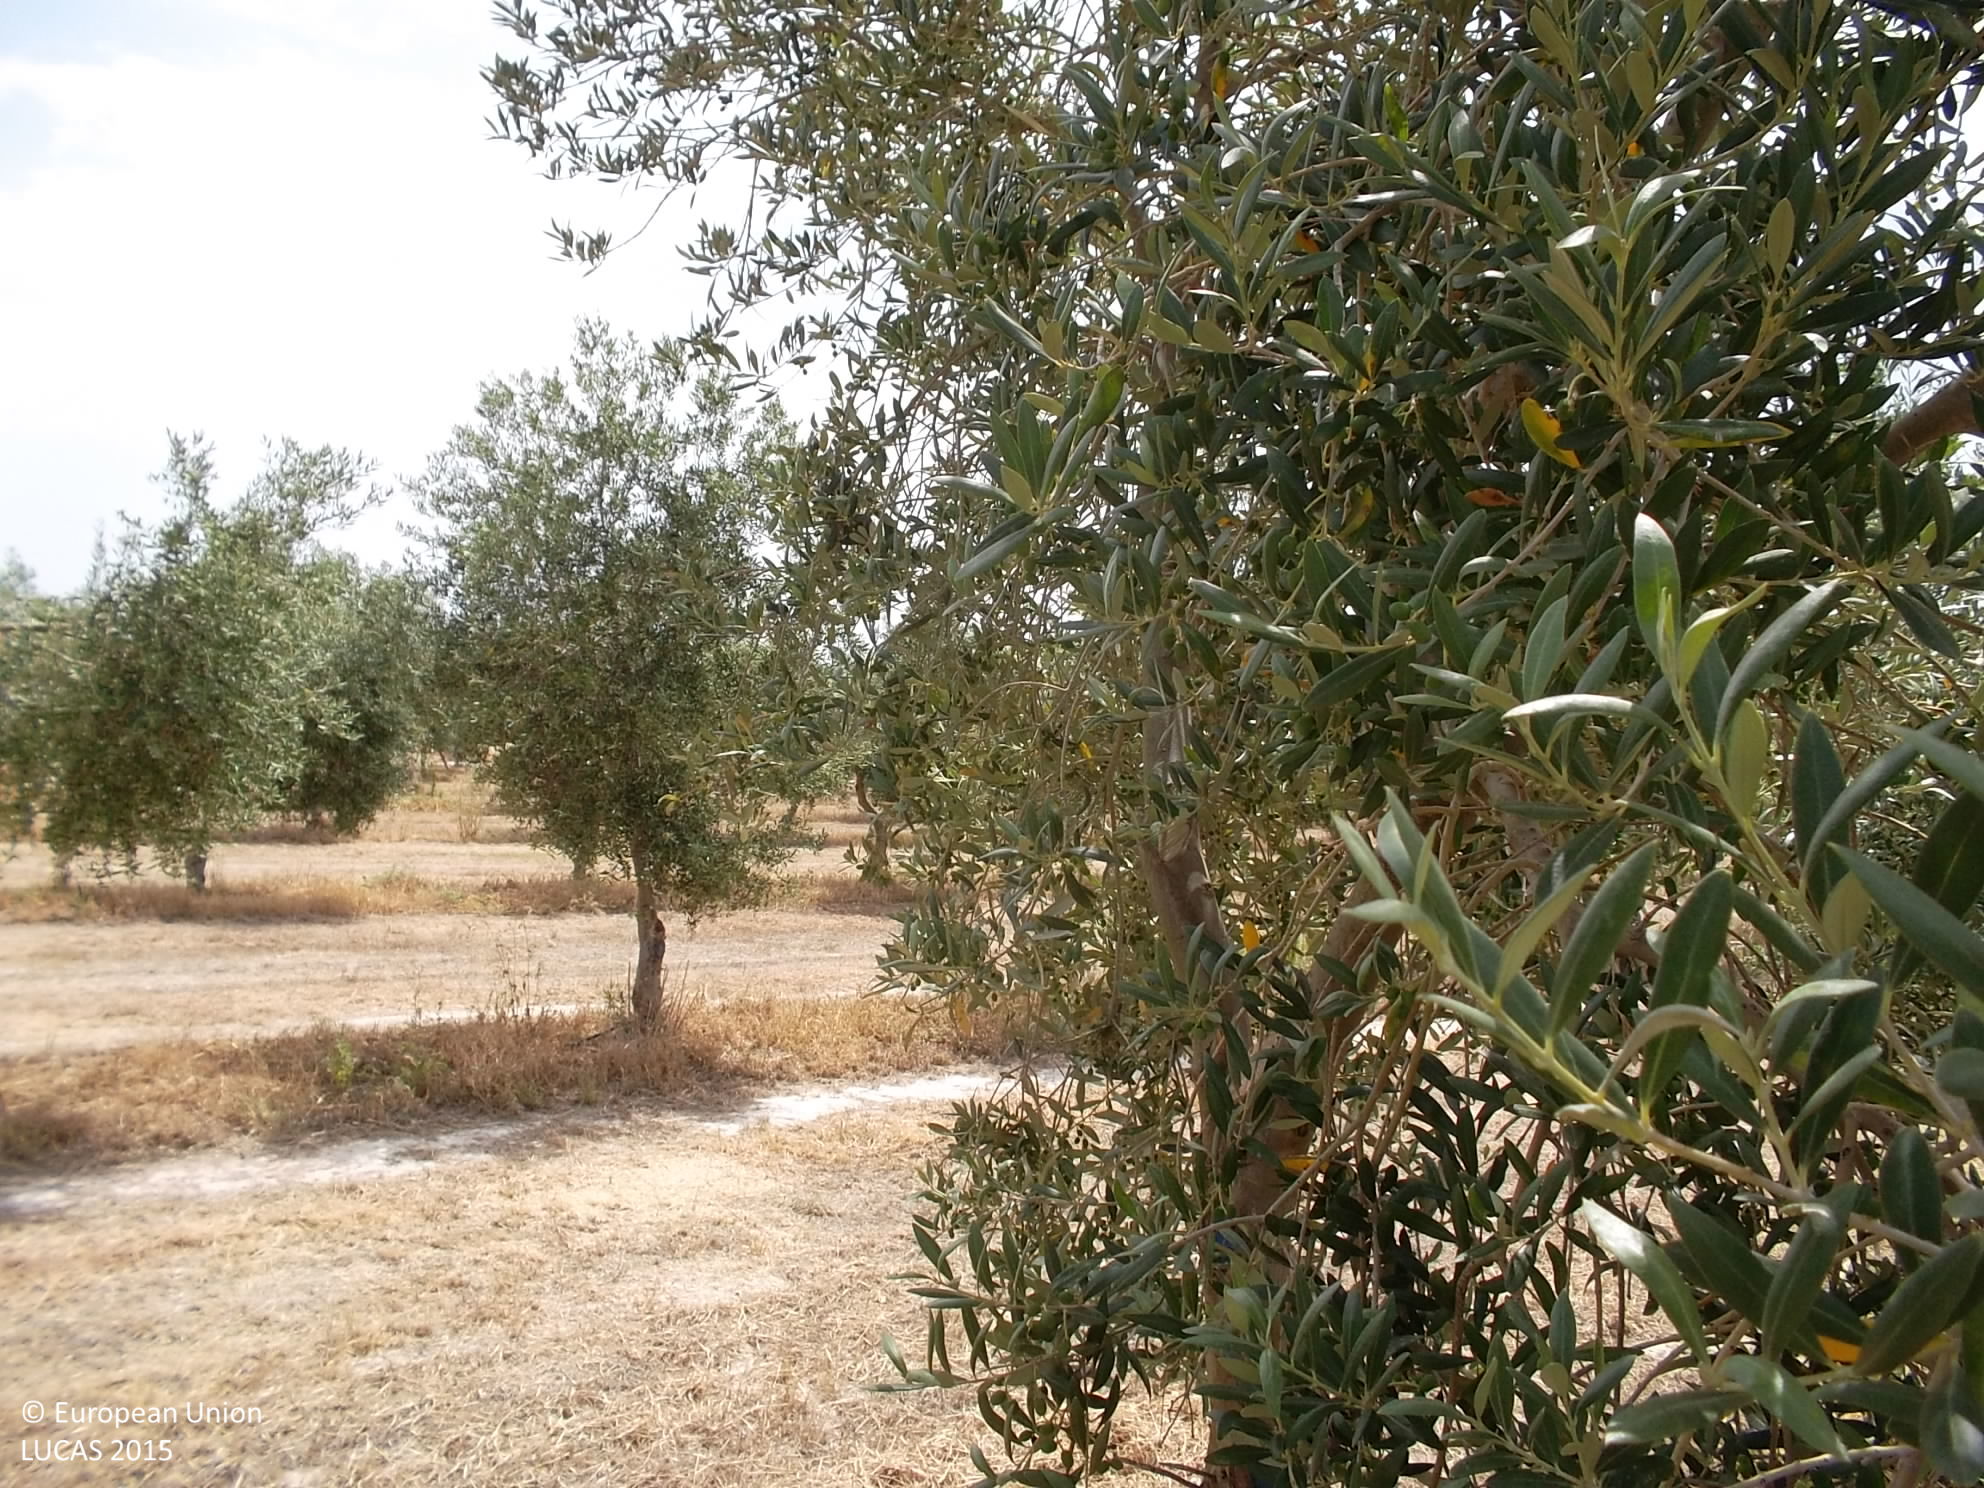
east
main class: Cropland
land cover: Olive groves
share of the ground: 50 - 75 %
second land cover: Spontaneously vegetated surfaces
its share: > 75 %
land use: Agriculture (excluding fallow land and kitchen gardens)
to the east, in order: Olive groves; Spontaneously vegetated surfaces; Tracks; Ditches and canals; Groves; Common wheat; Groves; Ditches and canals; Shrubland without tree cover; Olive groves; Electric lines; Olive groves; Grass margins; Nuts trees
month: July
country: ES
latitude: 37.5434
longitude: -2.7659
